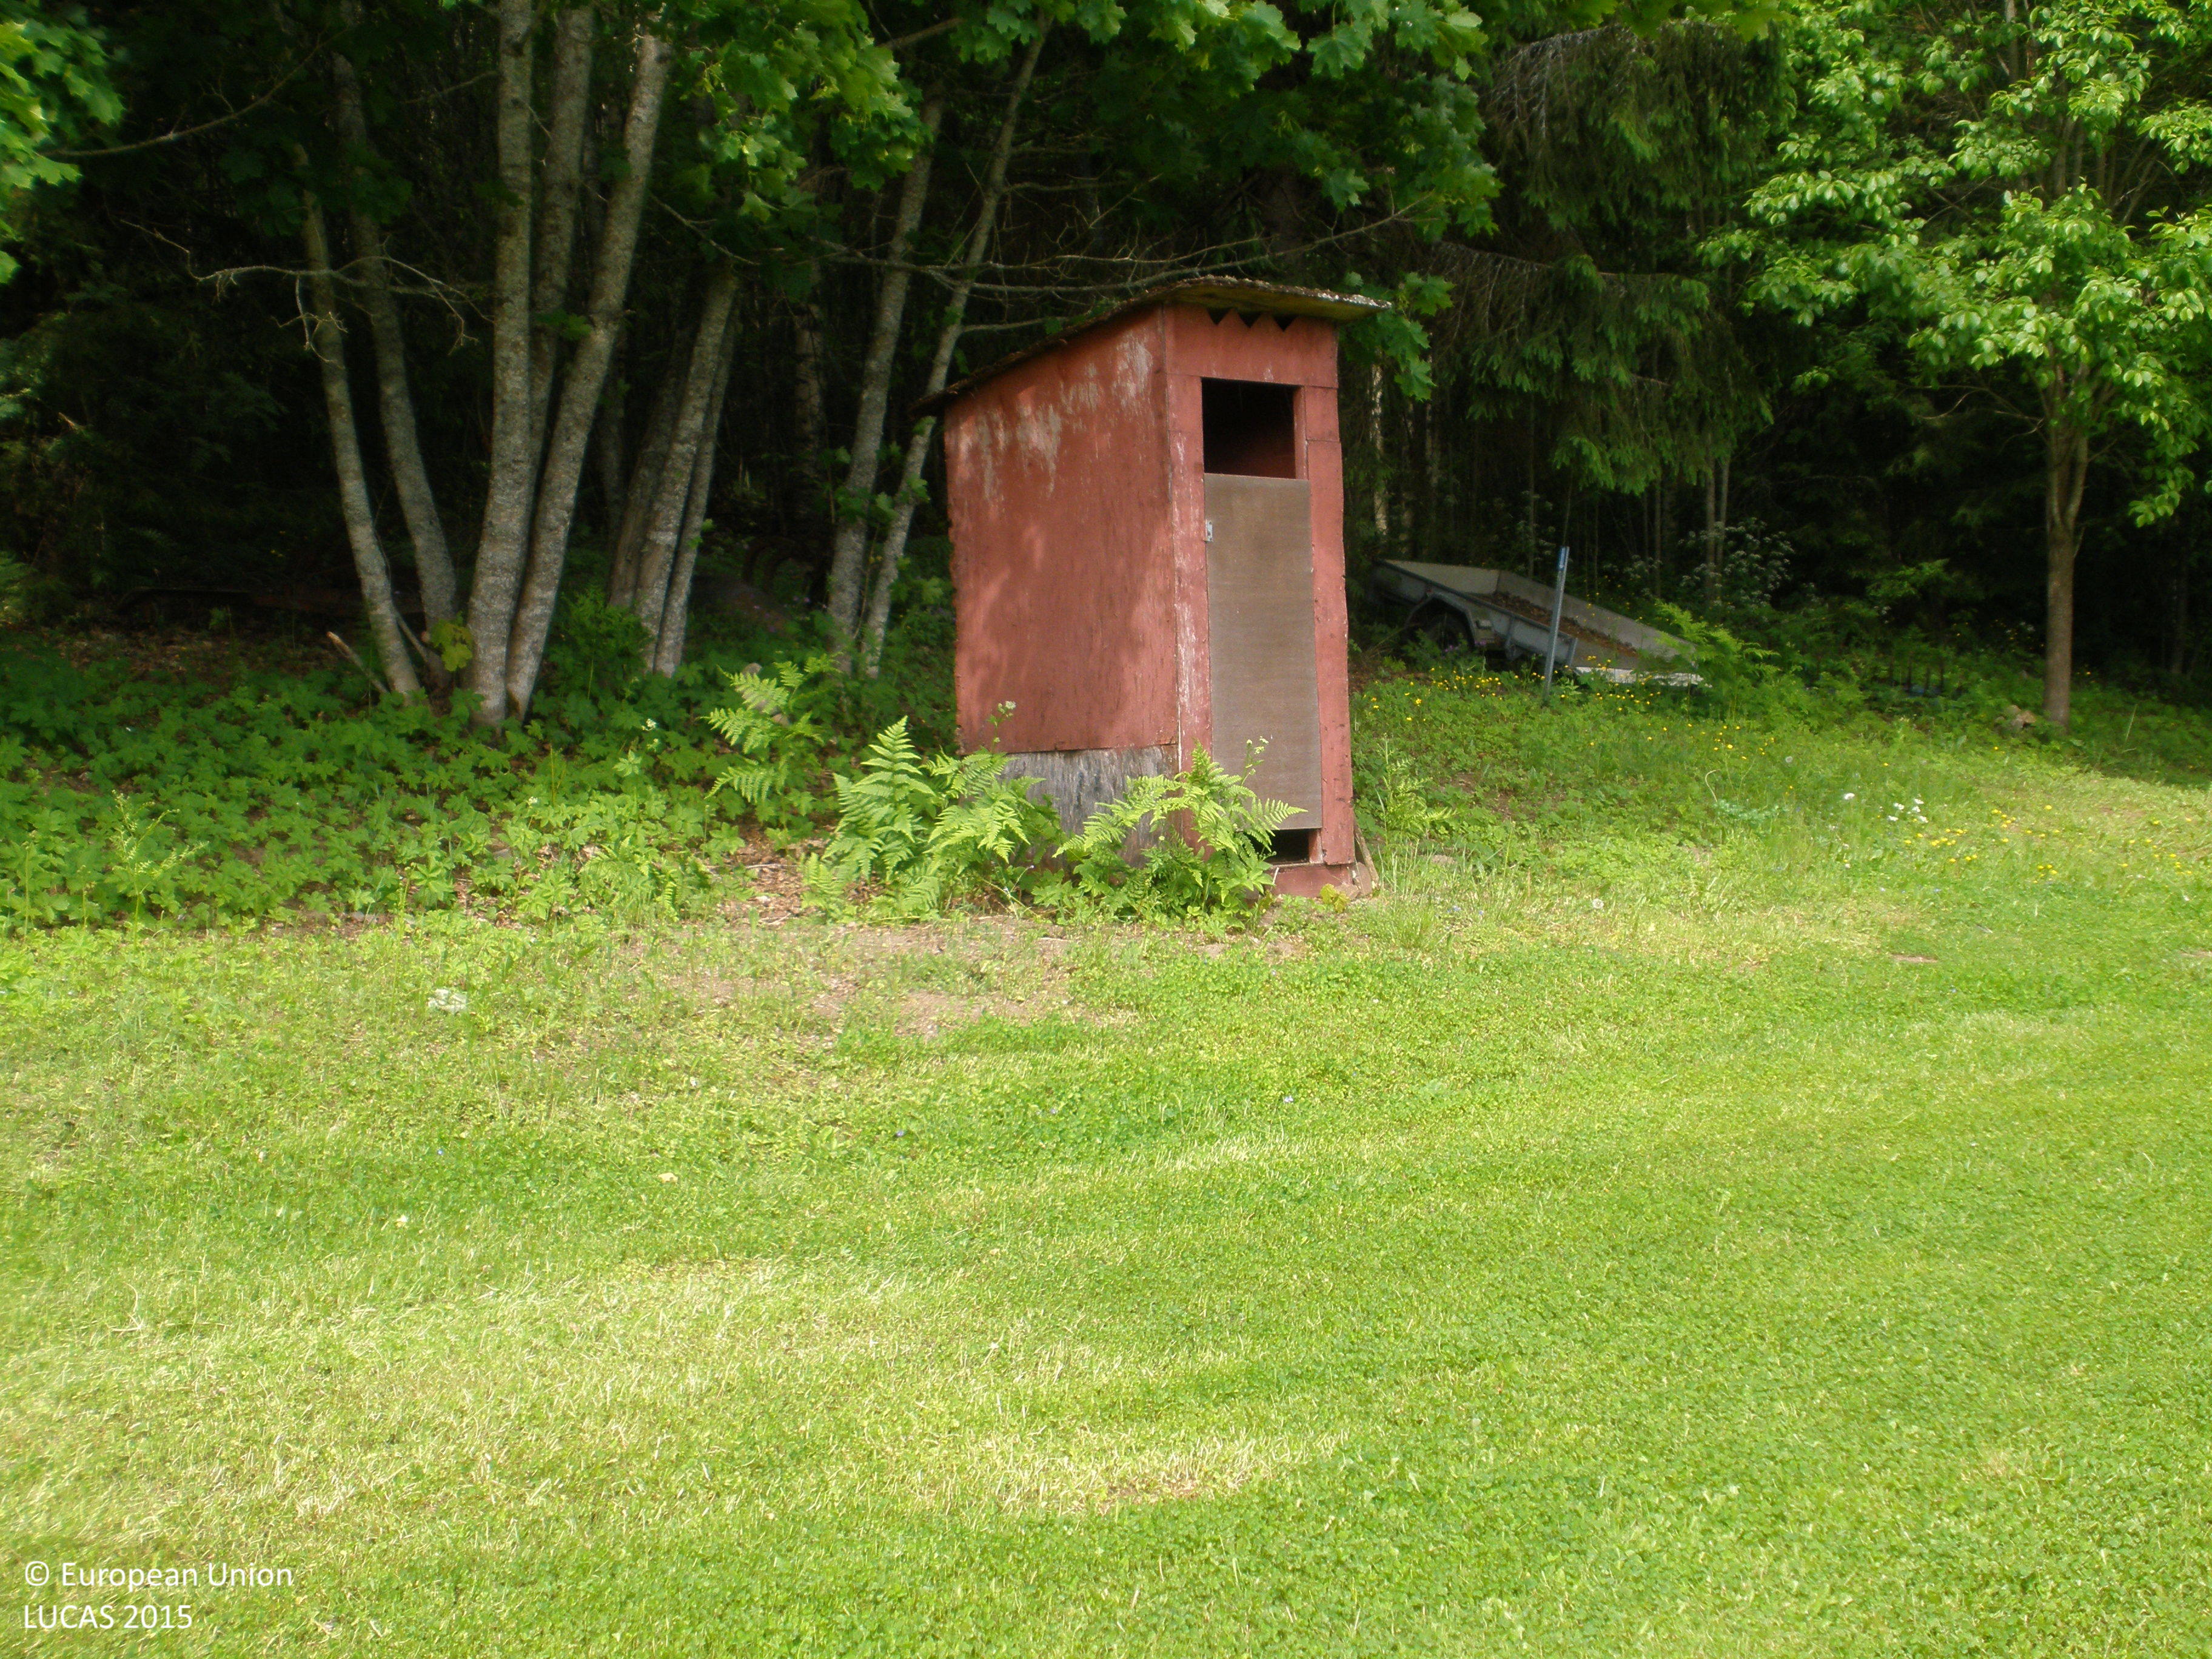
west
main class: Grassland
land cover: Grassland without tree/shrub cover
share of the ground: > 75 %
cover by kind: herbaceous plants 60 %, unconsolidated bare surface 40 %
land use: Residential
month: June
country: FI
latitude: 61.3381
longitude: 24.4717
